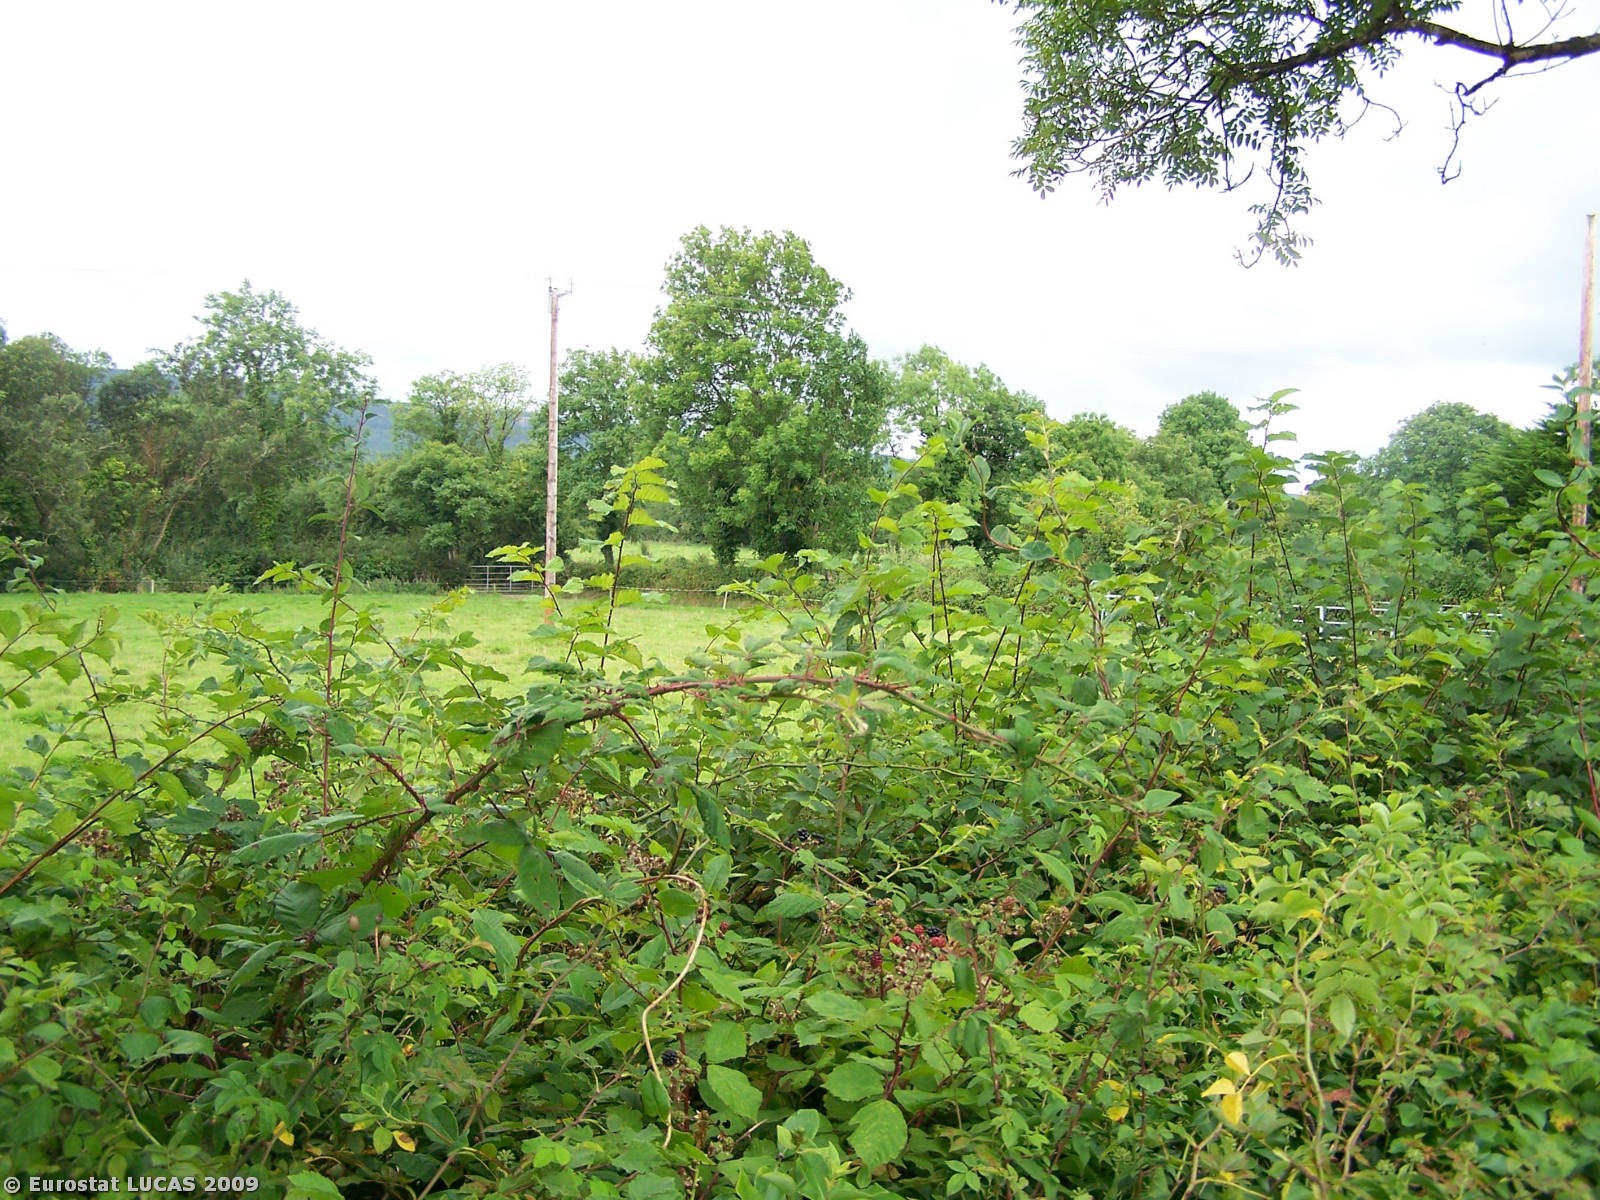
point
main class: Grassland
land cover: Grassland without tree/shrub cover
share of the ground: > 75 %
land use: Agriculture (excluding fallow land and kitchen gardens)
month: August
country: IE
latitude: 52.1432
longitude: -8.8378
